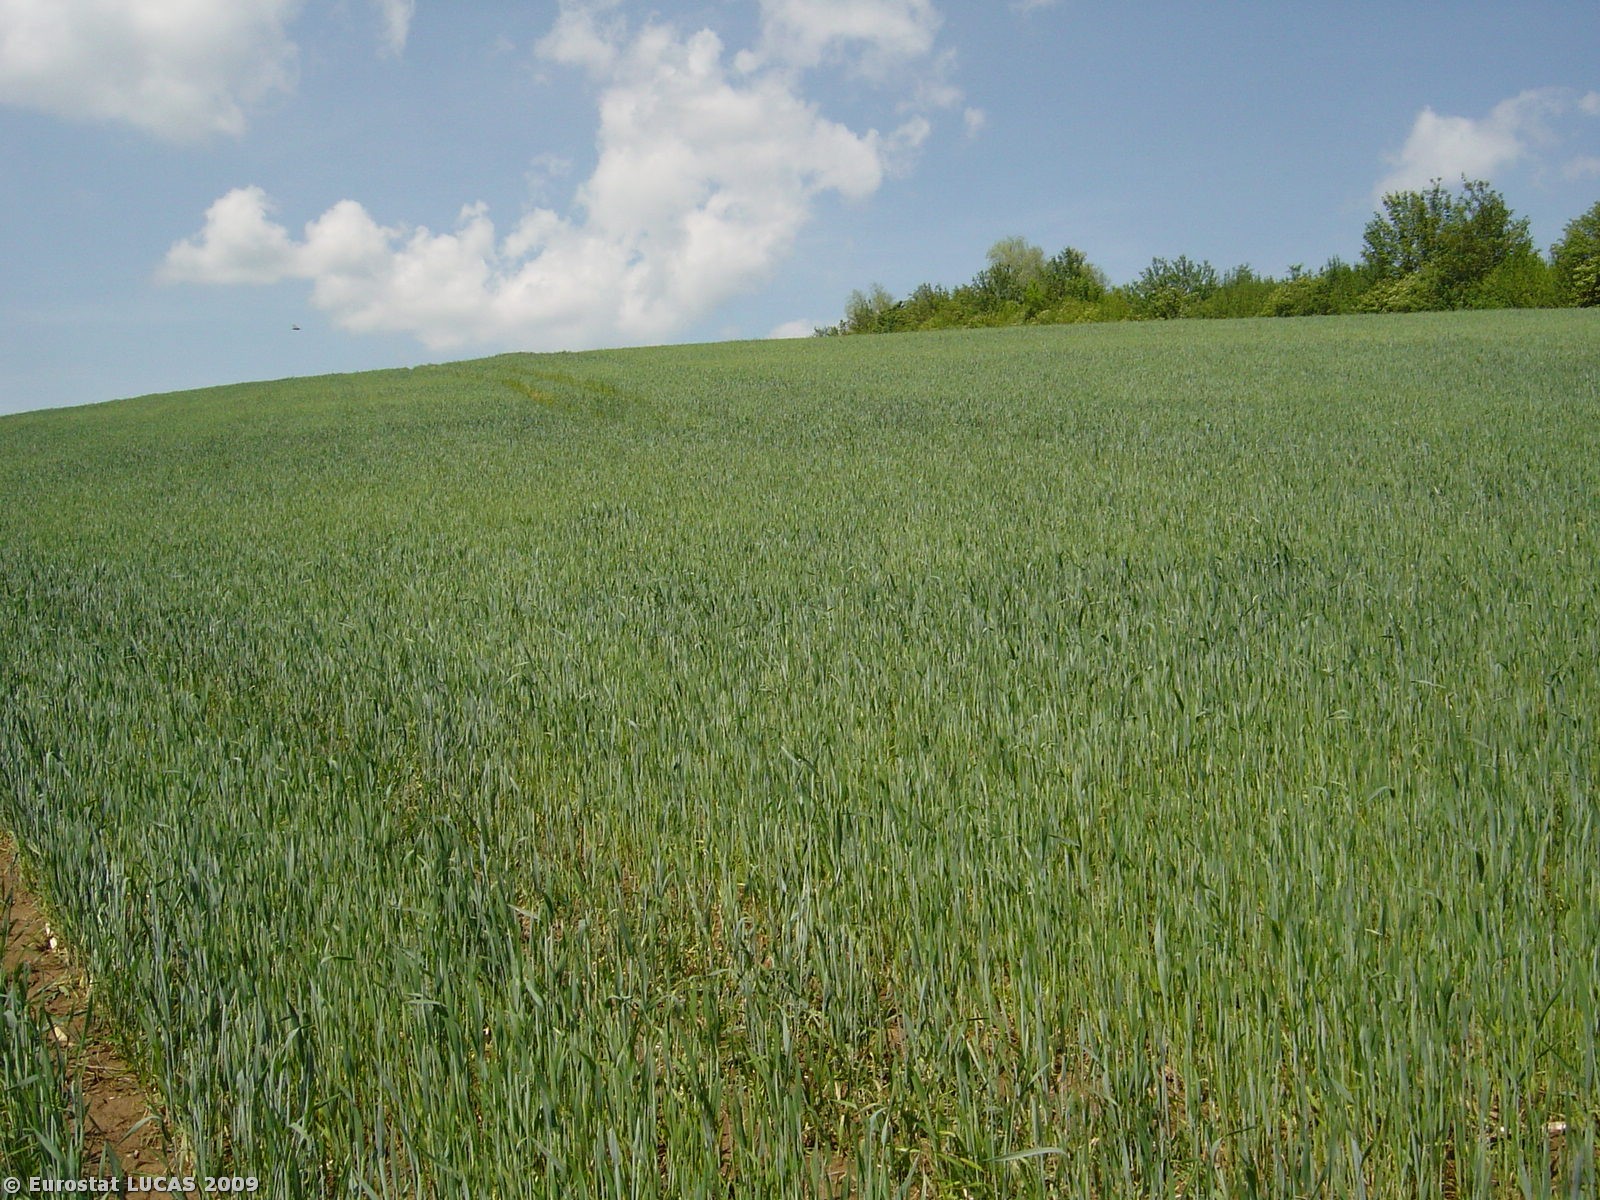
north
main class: Cropland
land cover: Common wheat
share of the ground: > 75 %
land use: Agriculture (excluding fallow land and kitchen gardens)
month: May
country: CZ
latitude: 49.0414
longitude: 17.1095
